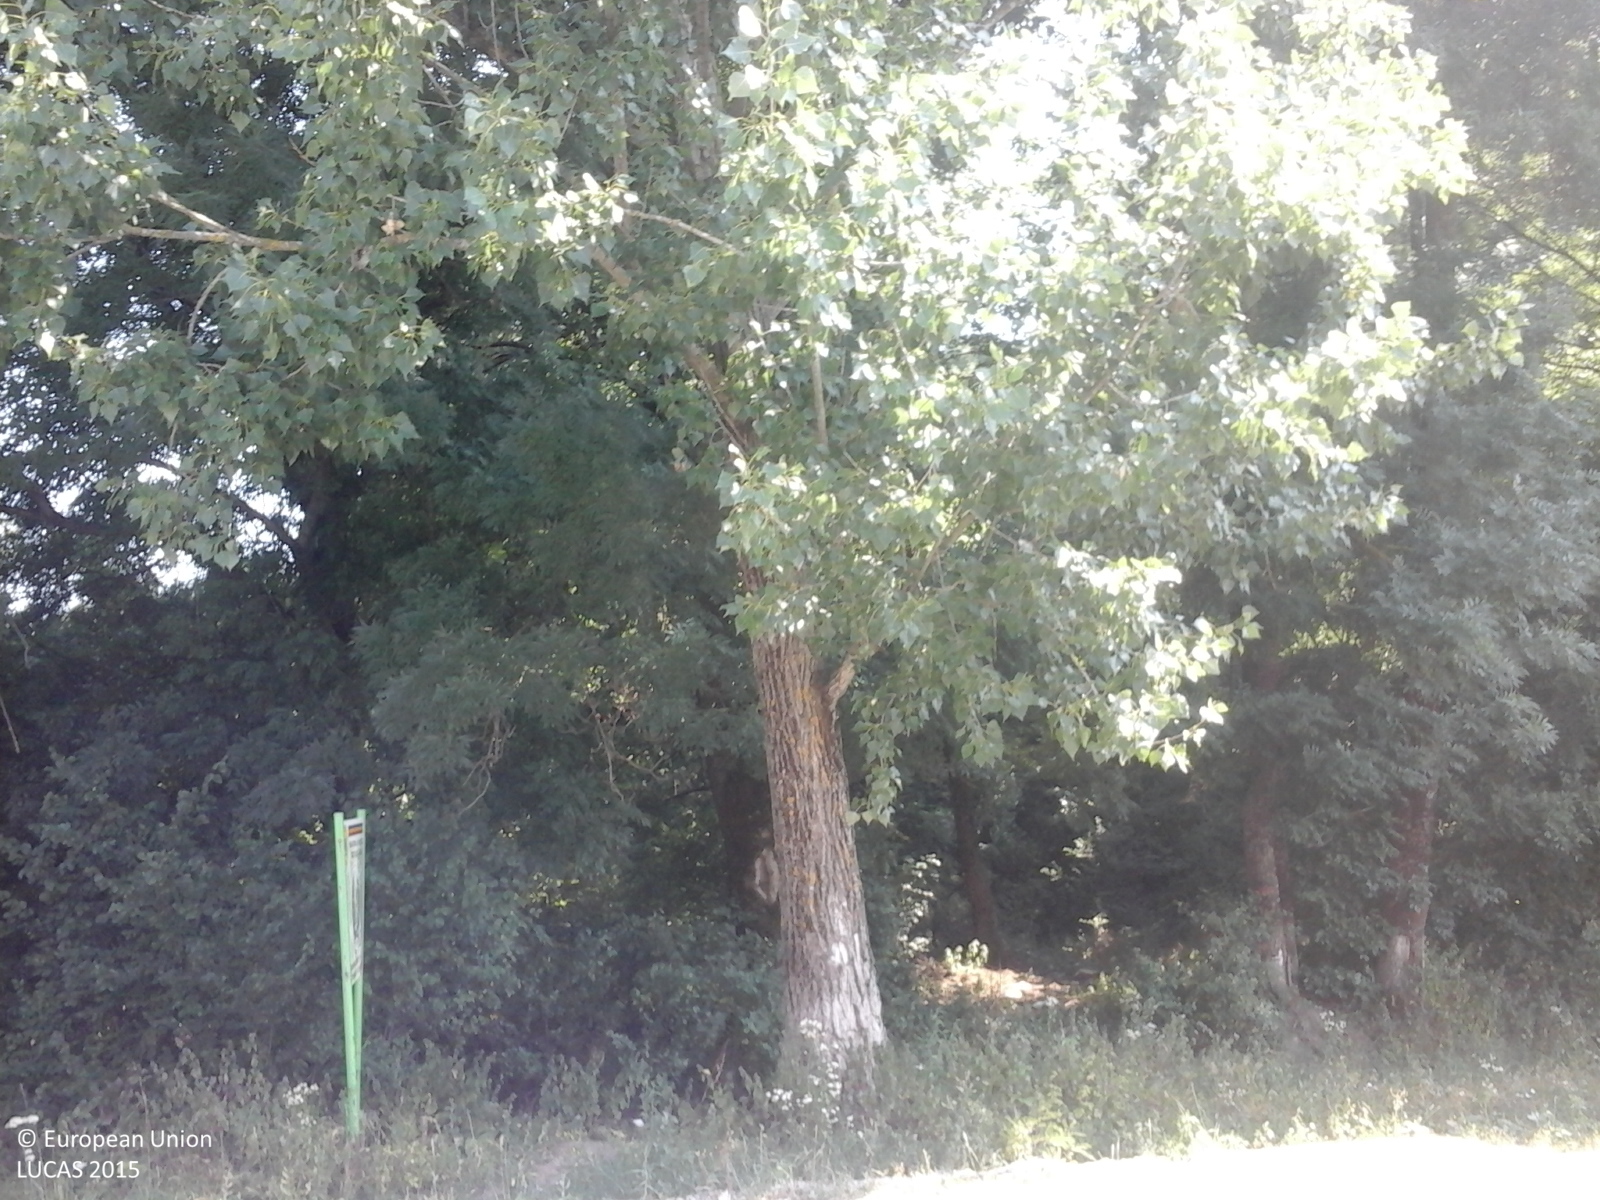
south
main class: Grassland
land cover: Spontaneously vegetated surfaces
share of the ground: > 75 %
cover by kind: herbaceous plants 100 %
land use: Fallow land
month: July
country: RO
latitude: 44.4970
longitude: 25.6264
